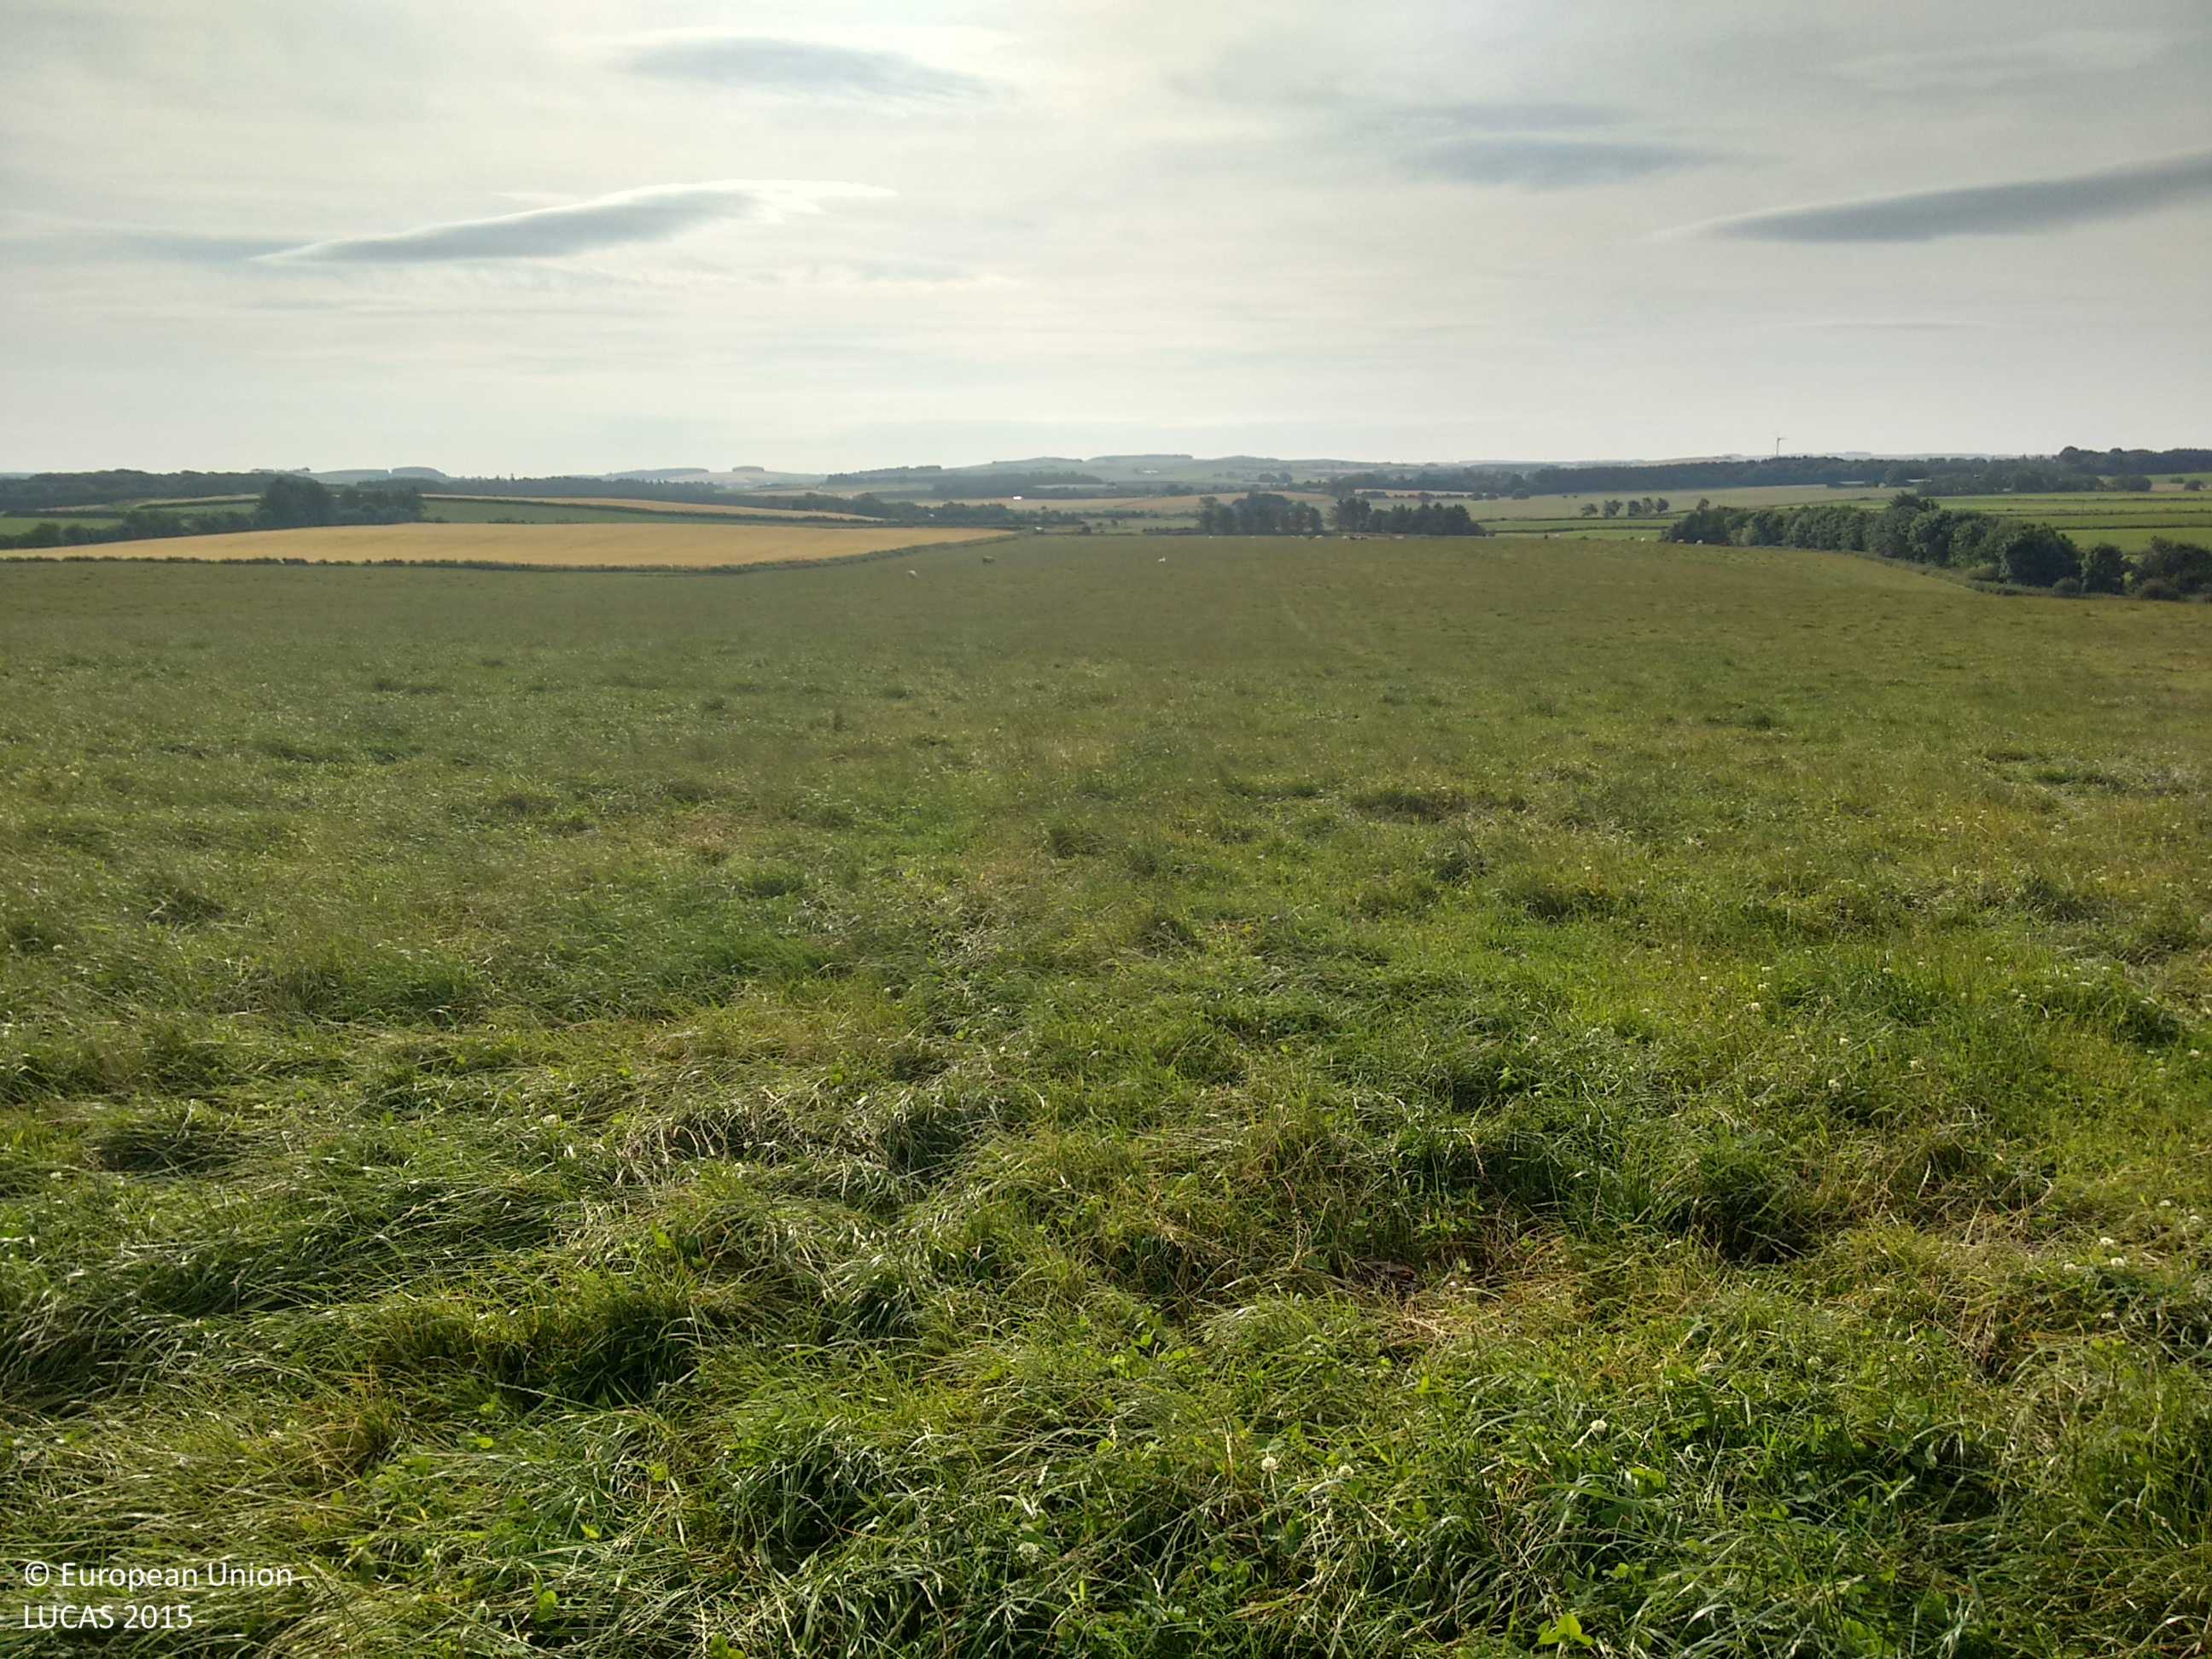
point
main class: Grassland
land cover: Grassland without tree/shrub cover
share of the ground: > 75 %
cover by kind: herbaceous plants 100 %
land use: Agriculture (excluding fallow land and kitchen gardens)
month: August
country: GB
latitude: 57.5345
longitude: -2.1908
